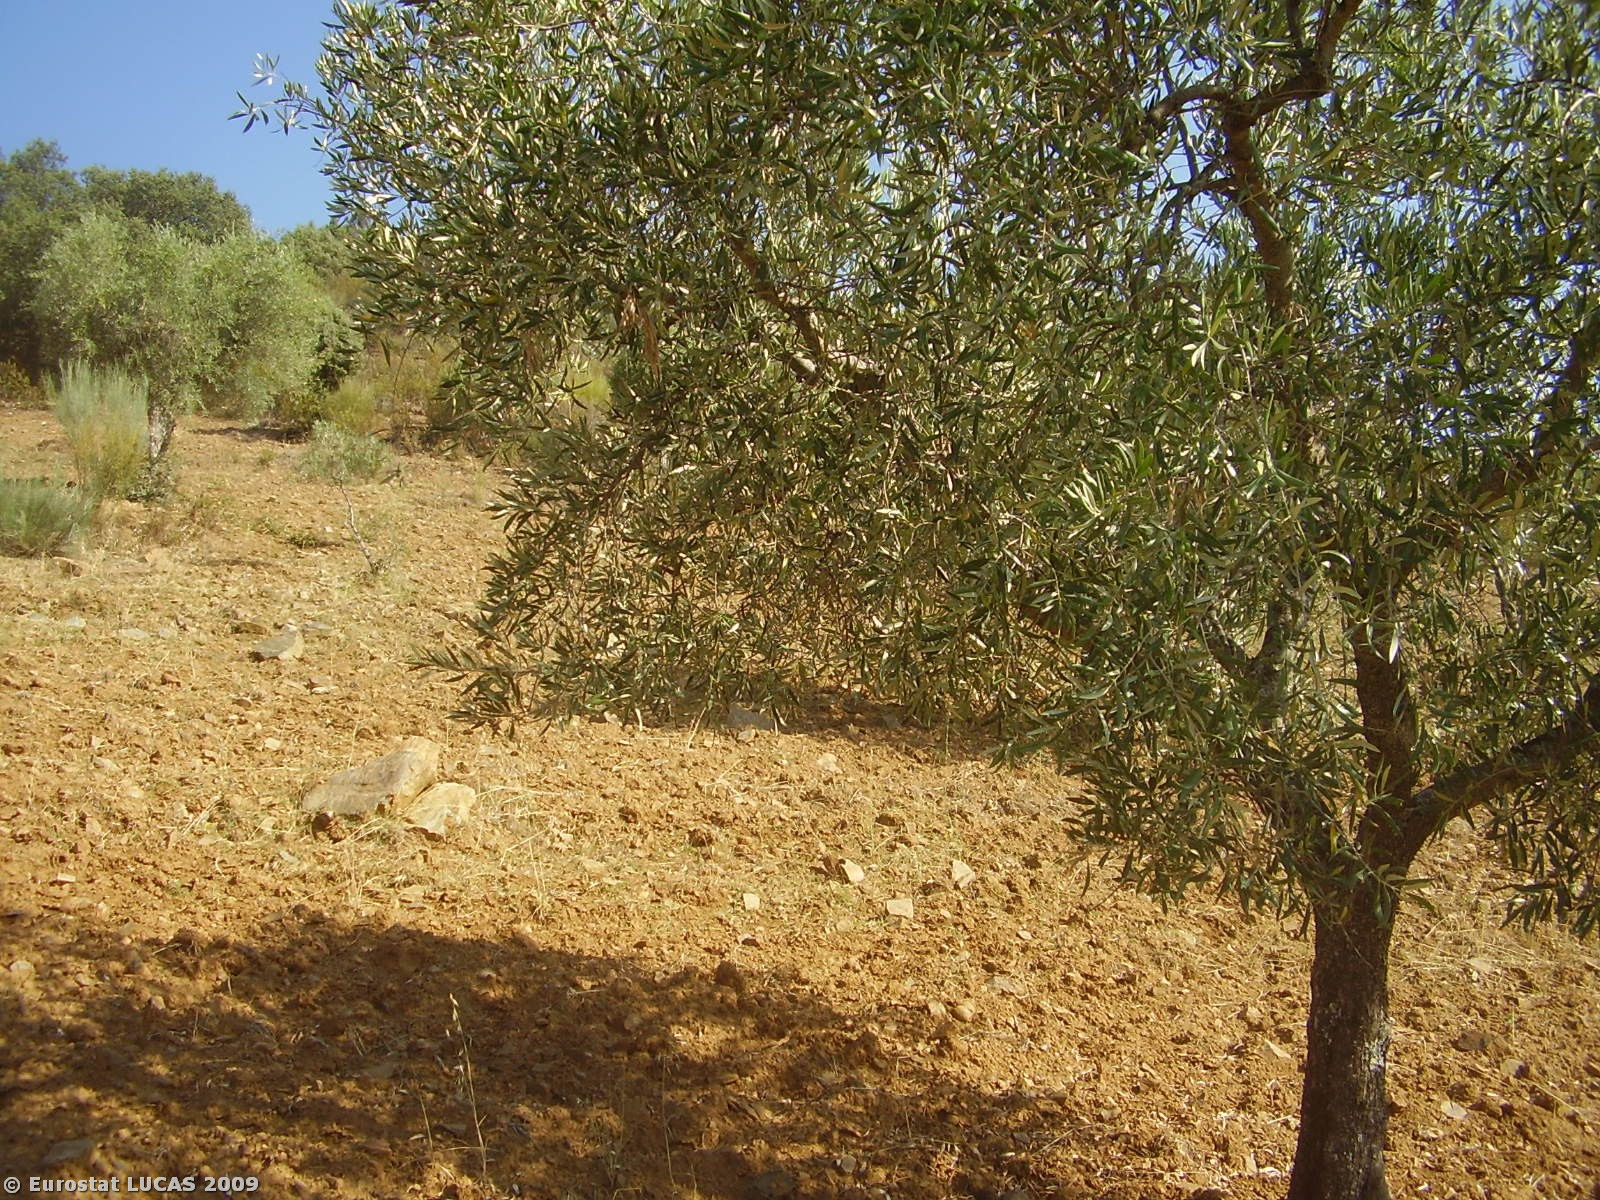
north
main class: Cropland
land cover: Olive groves
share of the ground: 10 - 25 %
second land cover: Bare land
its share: > 75 %
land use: Agriculture (excluding fallow land and kitchen gardens)
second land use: Fallow land
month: August
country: PT
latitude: 41.4014
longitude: -6.8187
